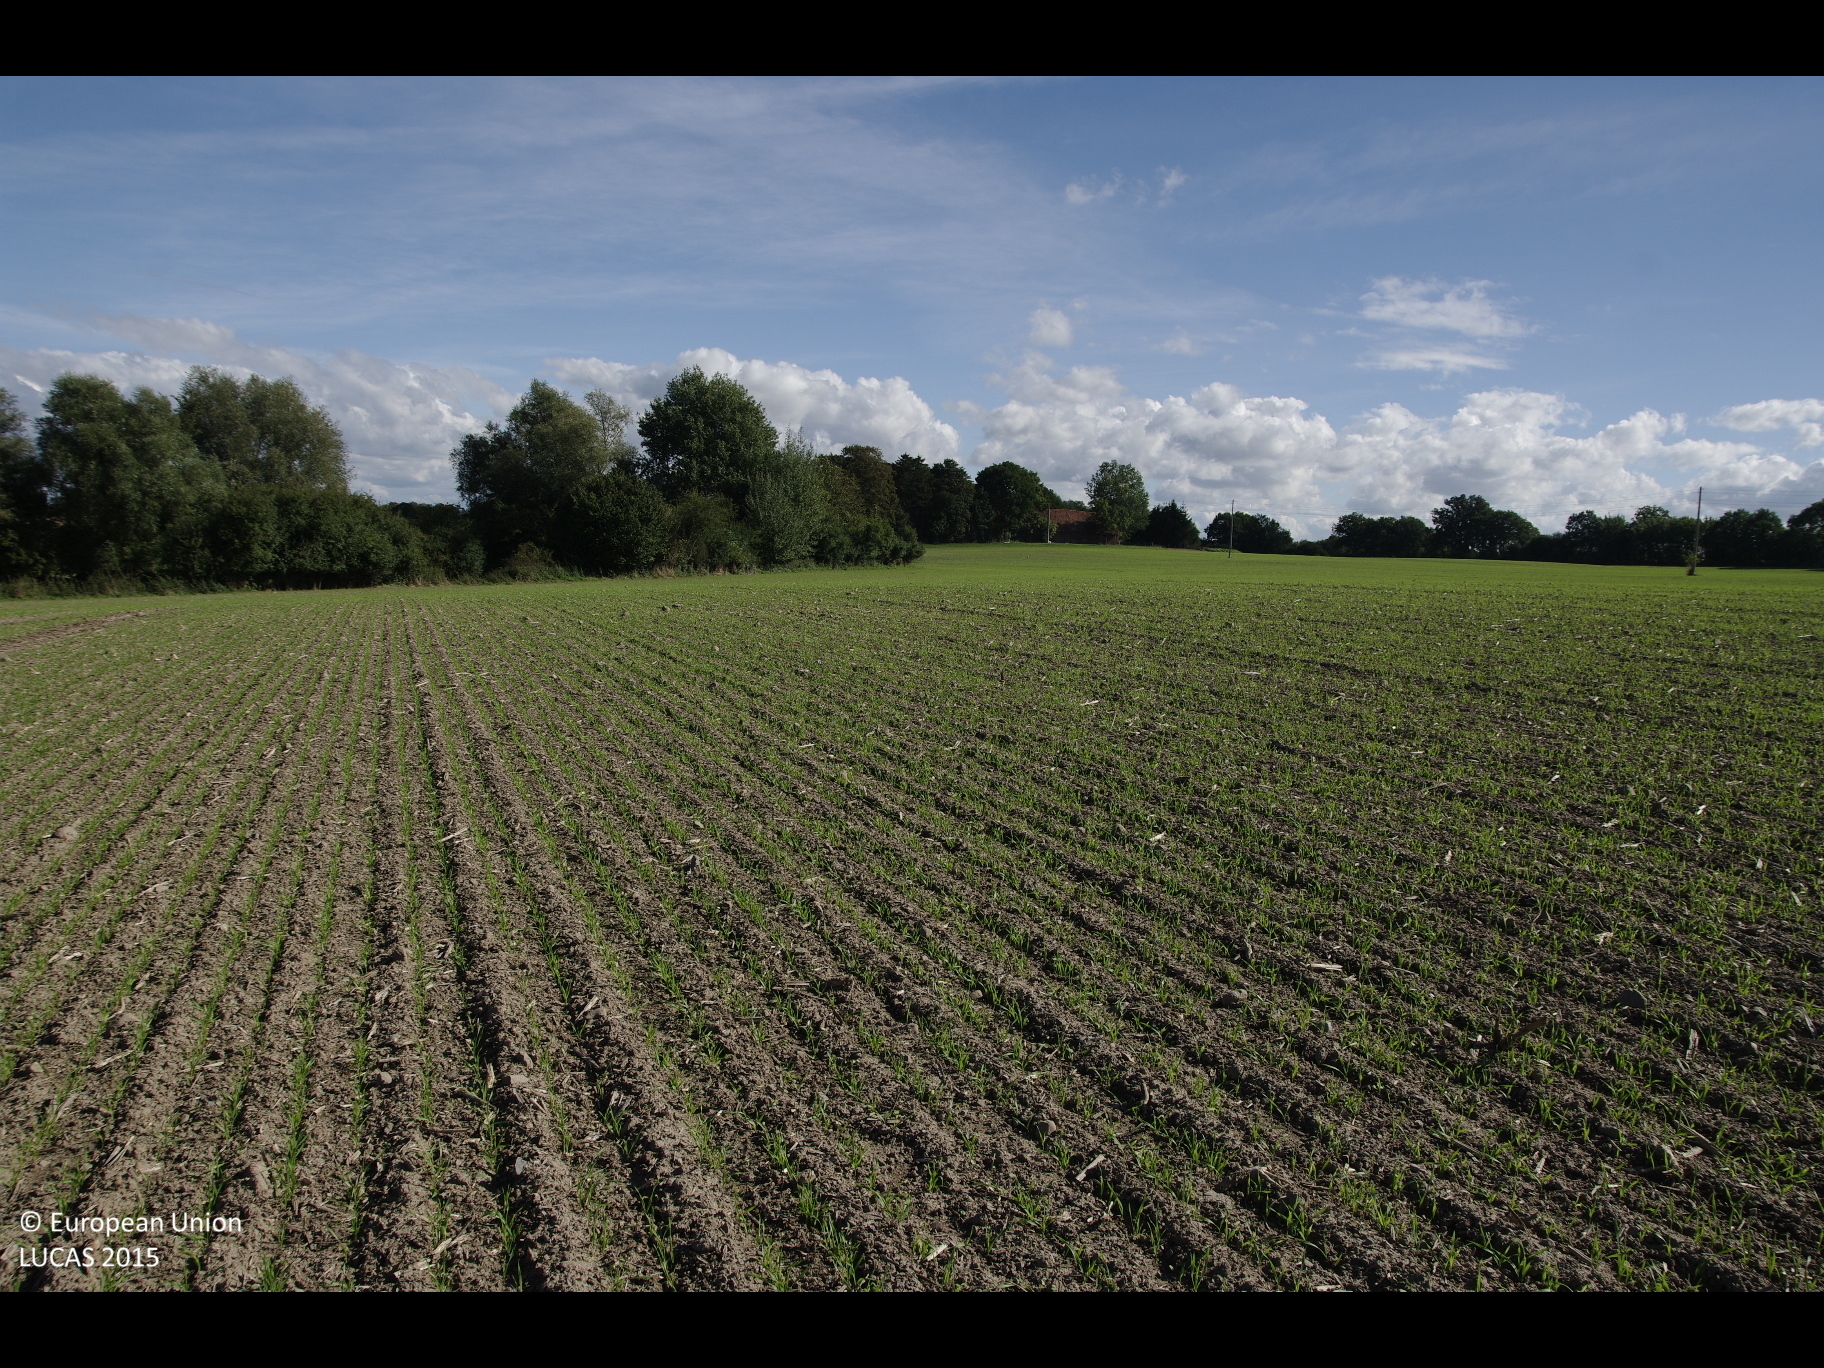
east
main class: Cropland
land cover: Rape and turnip rape
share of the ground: < 10 %
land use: Agriculture (excluding fallow land and kitchen gardens)
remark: Harvested field
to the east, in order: Rape and turnip rape; Abandoned hedges; Fences; Grassland without tree/shrub cover; Fences; Broadleaved woodland; Rape and turnip rape; Artificial constructions in urban areas
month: September
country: DE
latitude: 53.9178
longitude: 11.1413
